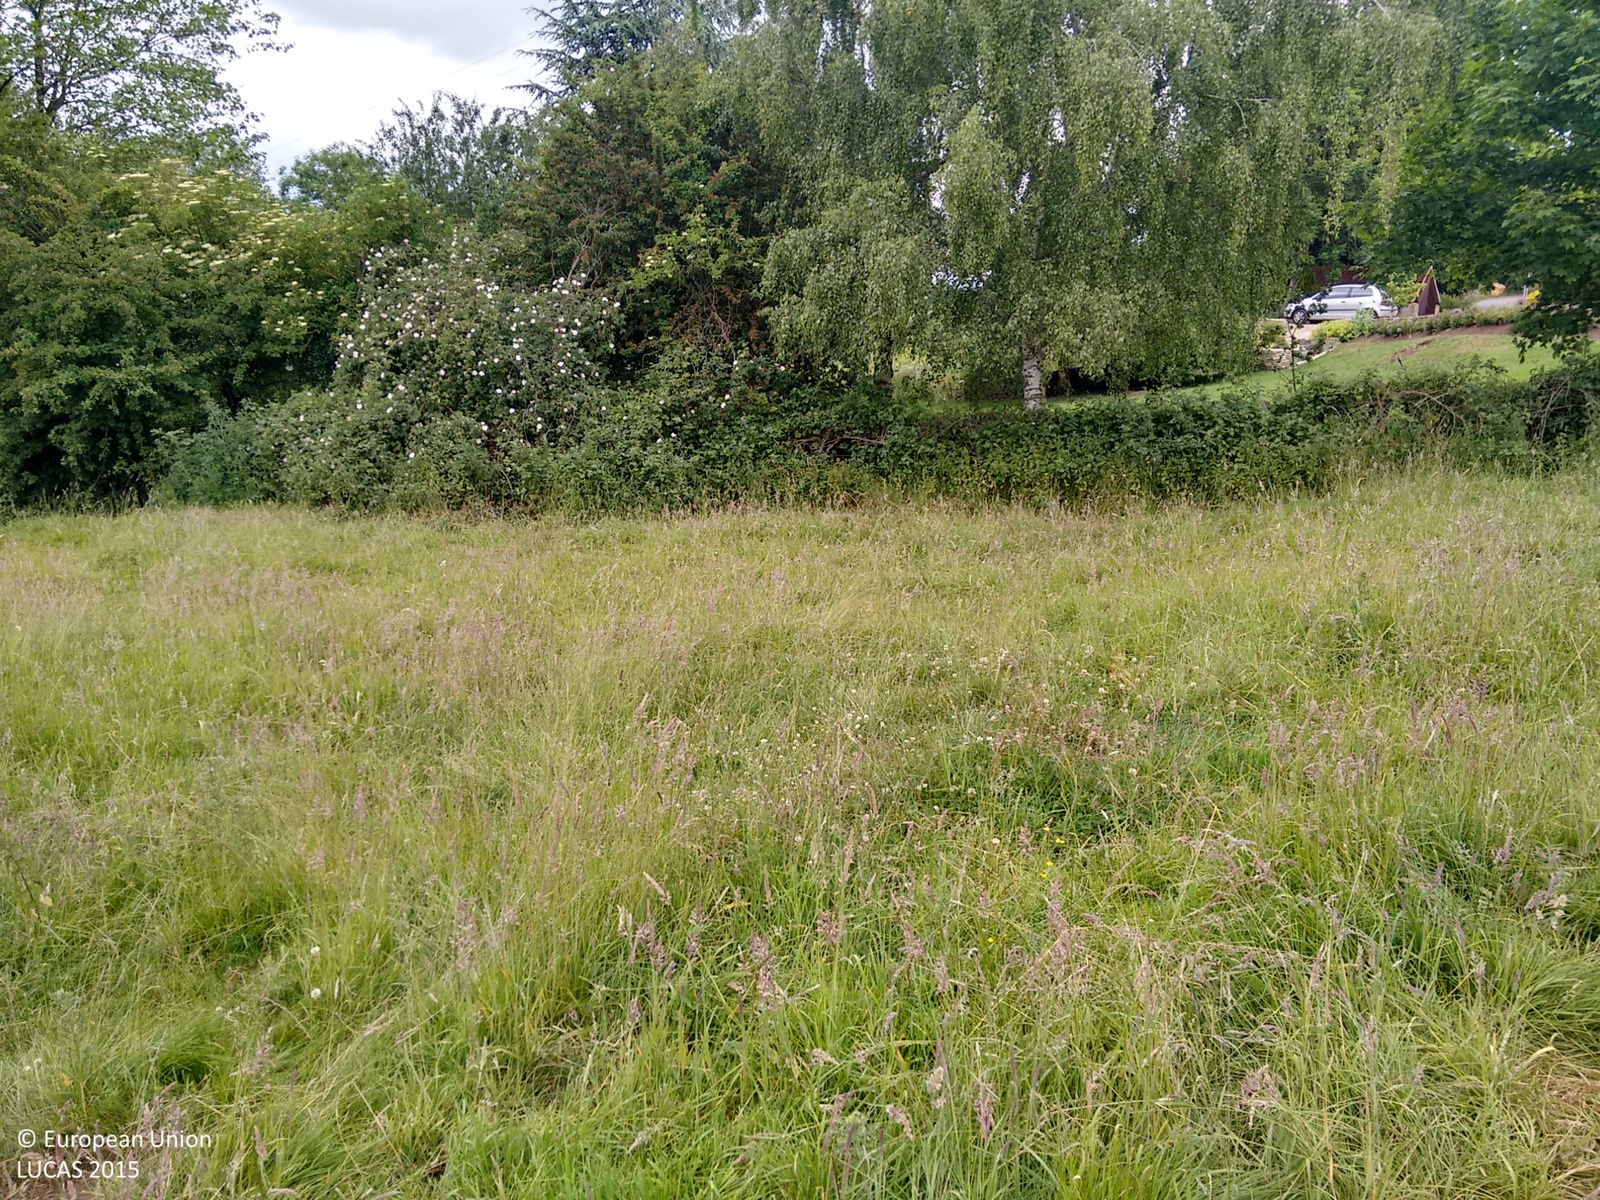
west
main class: Grassland
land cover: Grassland without tree/shrub cover
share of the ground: > 75 %
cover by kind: herbaceous plants 100 %
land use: Agriculture (excluding fallow land and kitchen gardens)
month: June
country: GB
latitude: 51.5967
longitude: -2.0558
